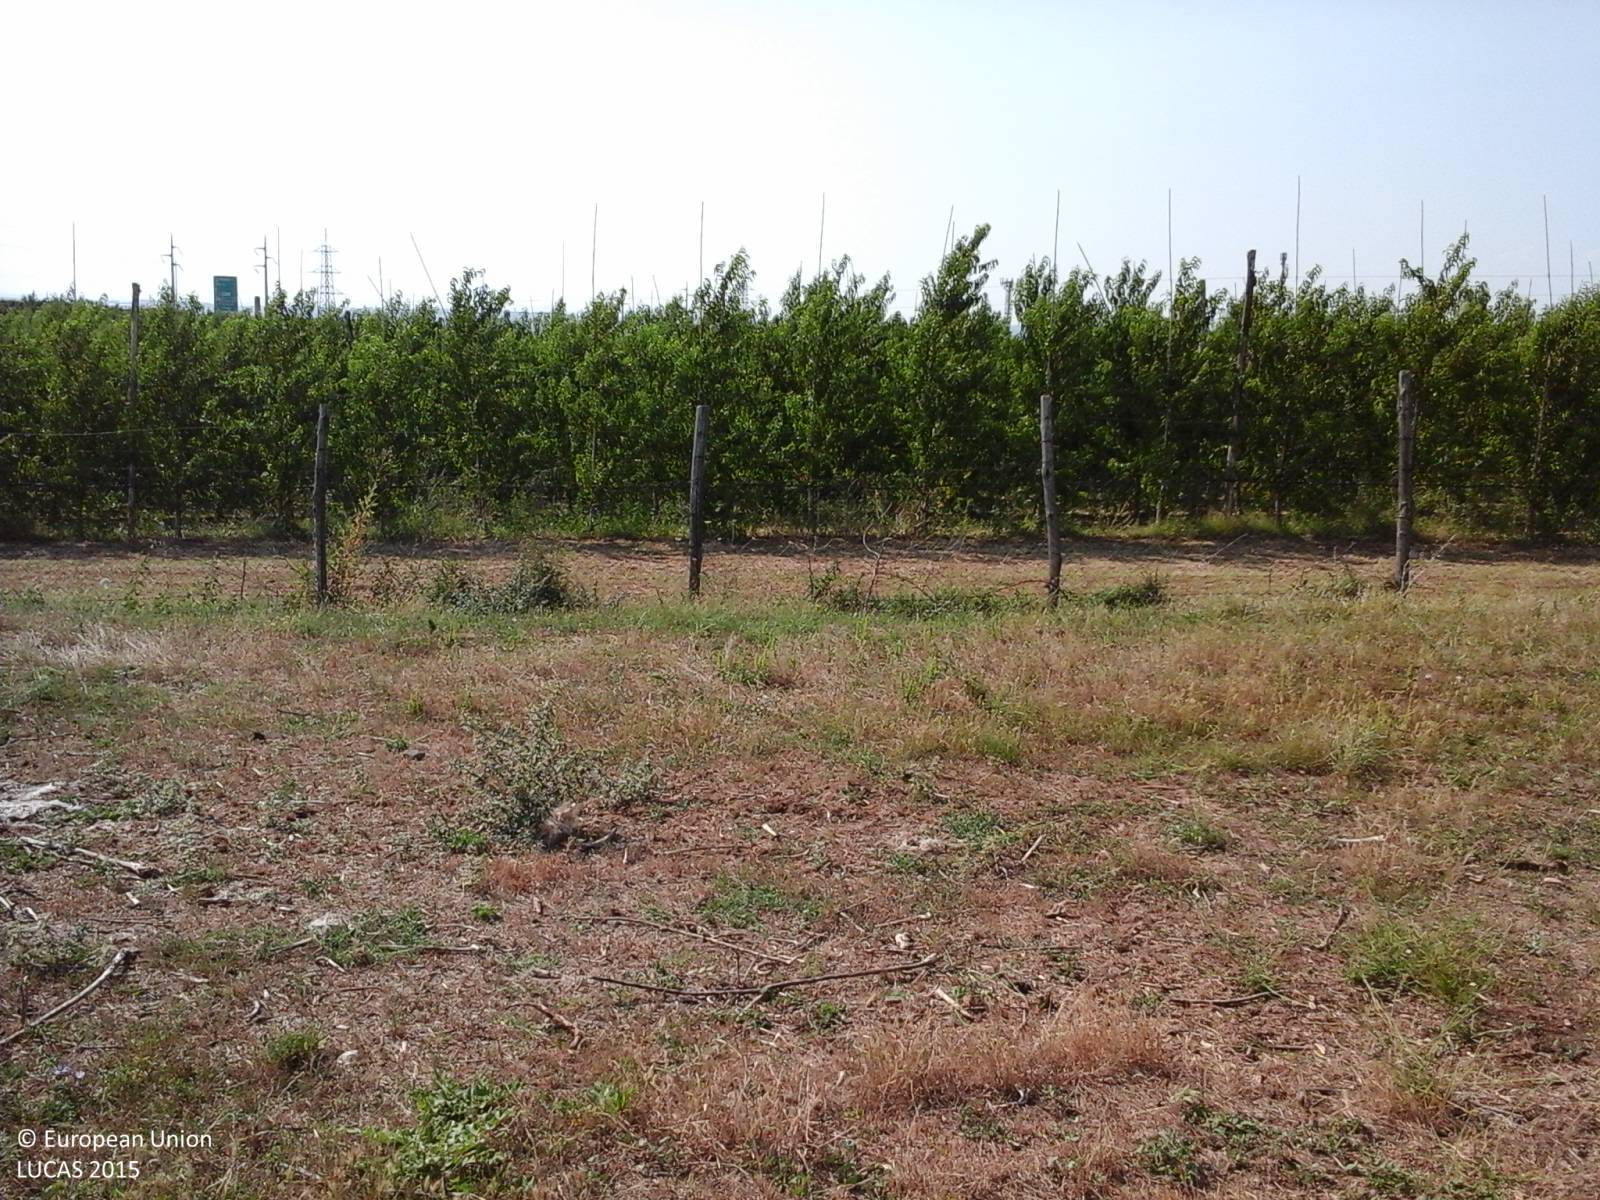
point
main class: Cropland
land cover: Other fruit trees and berries
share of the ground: > 75 %
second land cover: Spontaneously vegetated surfaces
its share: 50 - 75 %
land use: Agriculture (excluding fallow land and kitchen gardens)
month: July
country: IT
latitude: 41.9117
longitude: 12.7507
